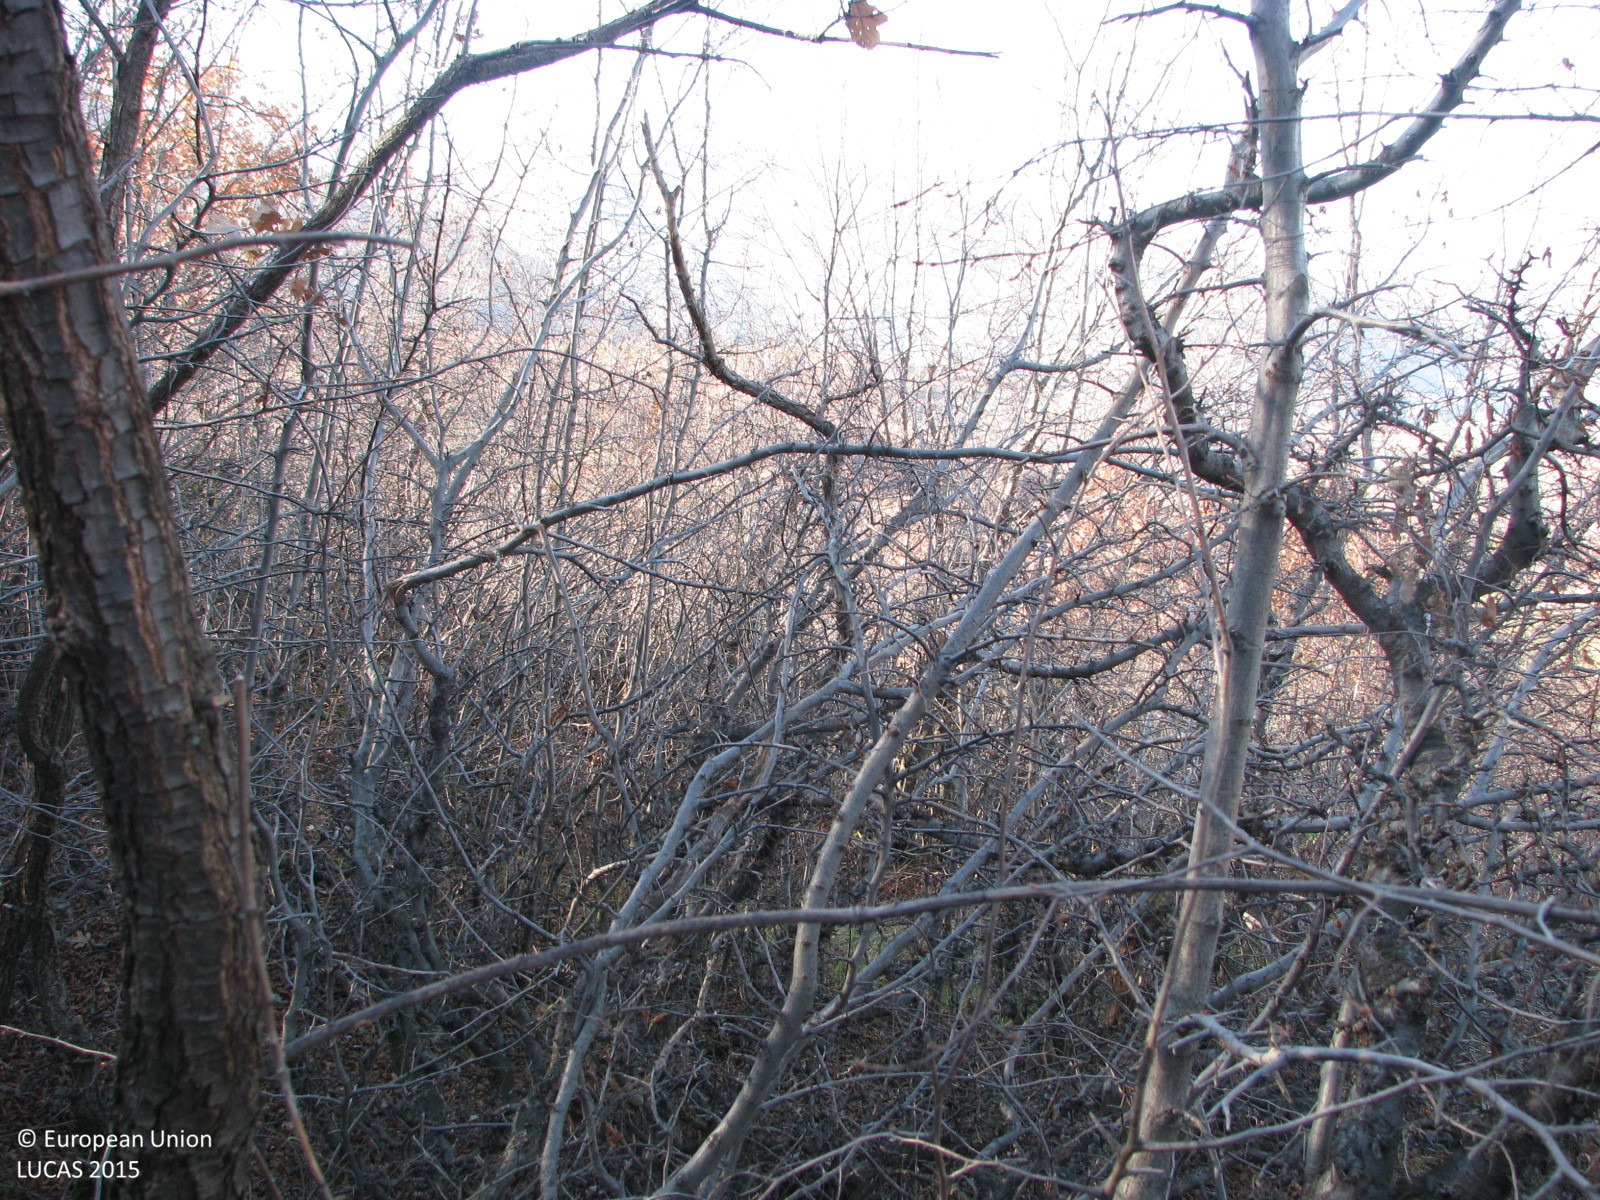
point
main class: Woodland
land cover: Broadleaved woodland
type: mesophytic deciduous forest
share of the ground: > 75 %
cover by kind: broadleaved forest trees 90 %, shrubs 5 %, unconsolidated bare surface 5 %
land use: Semi-natural and natural areas not in use
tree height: < 5 m
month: December
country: BG
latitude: 42.1474
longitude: 24.1630
